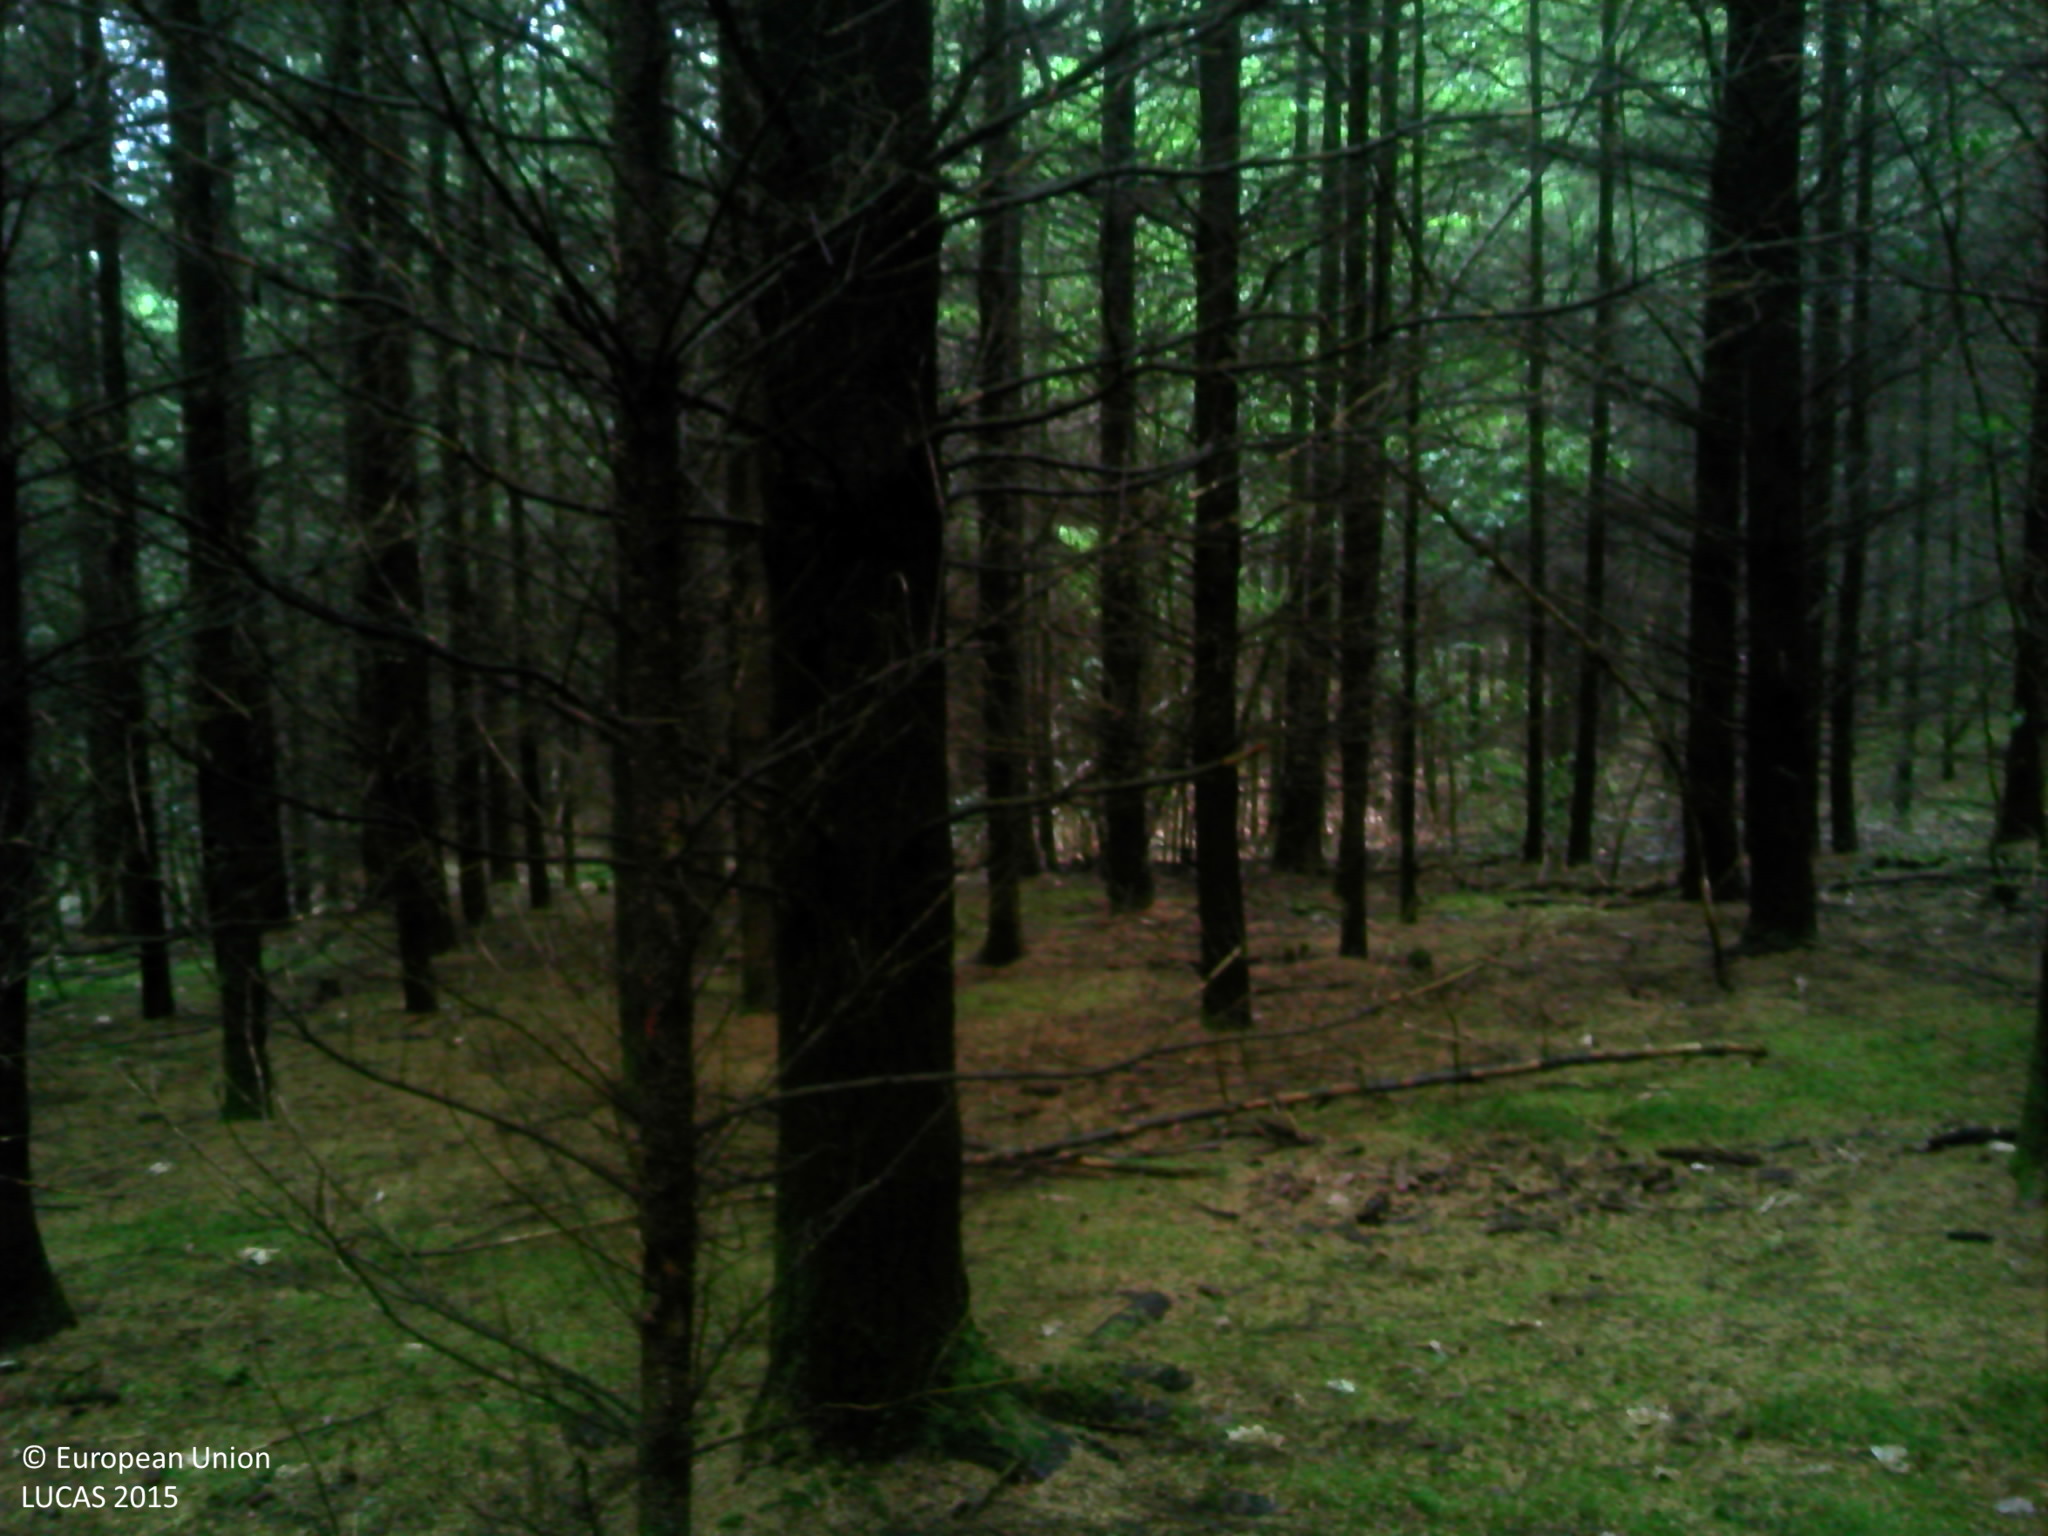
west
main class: Woodland
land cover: Other coniferous woodland
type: exotic forest
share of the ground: > 75 %
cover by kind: coniferous forest trees 90 %, herbaceous plants 10 %
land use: Forestry
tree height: > 5 m
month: July
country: FR
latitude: 46.4800
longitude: 4.4916
